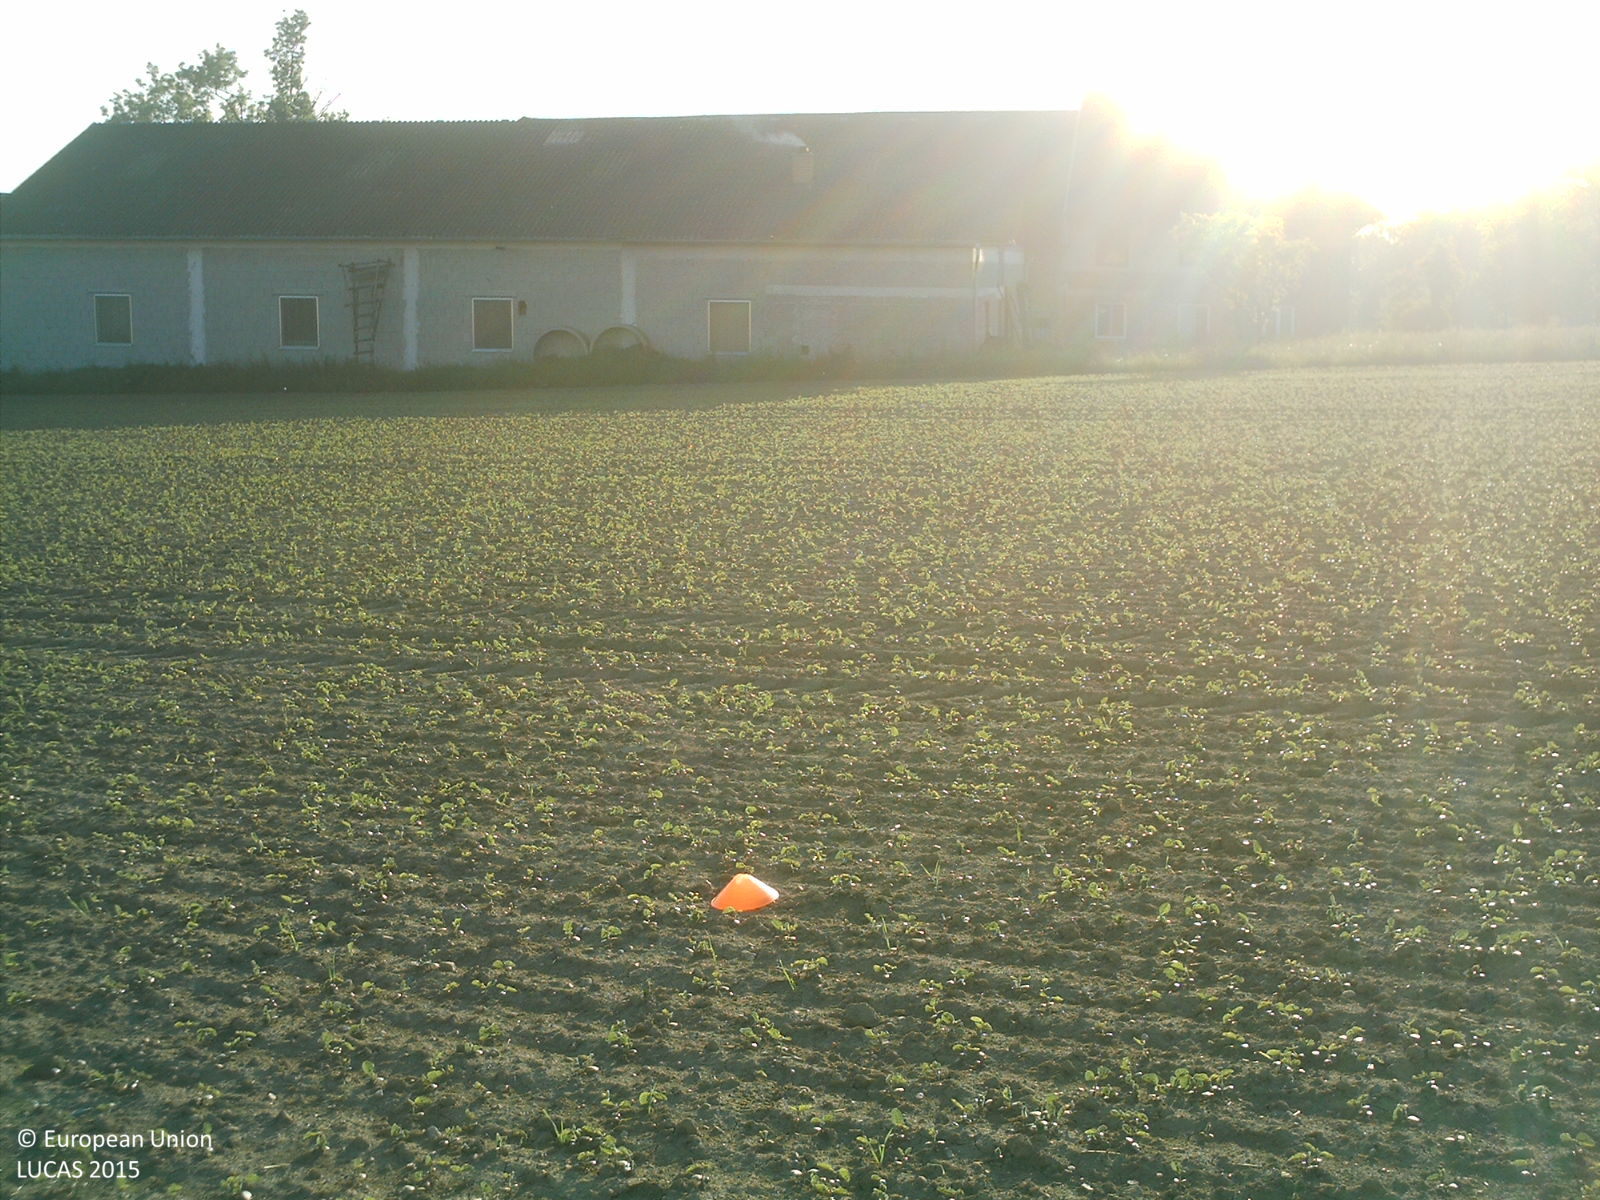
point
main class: Cropland
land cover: Soya
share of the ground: 50 - 75 %
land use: Agriculture (excluding fallow land and kitchen gardens)
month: May
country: AT
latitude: 48.0196
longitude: 14.1425
